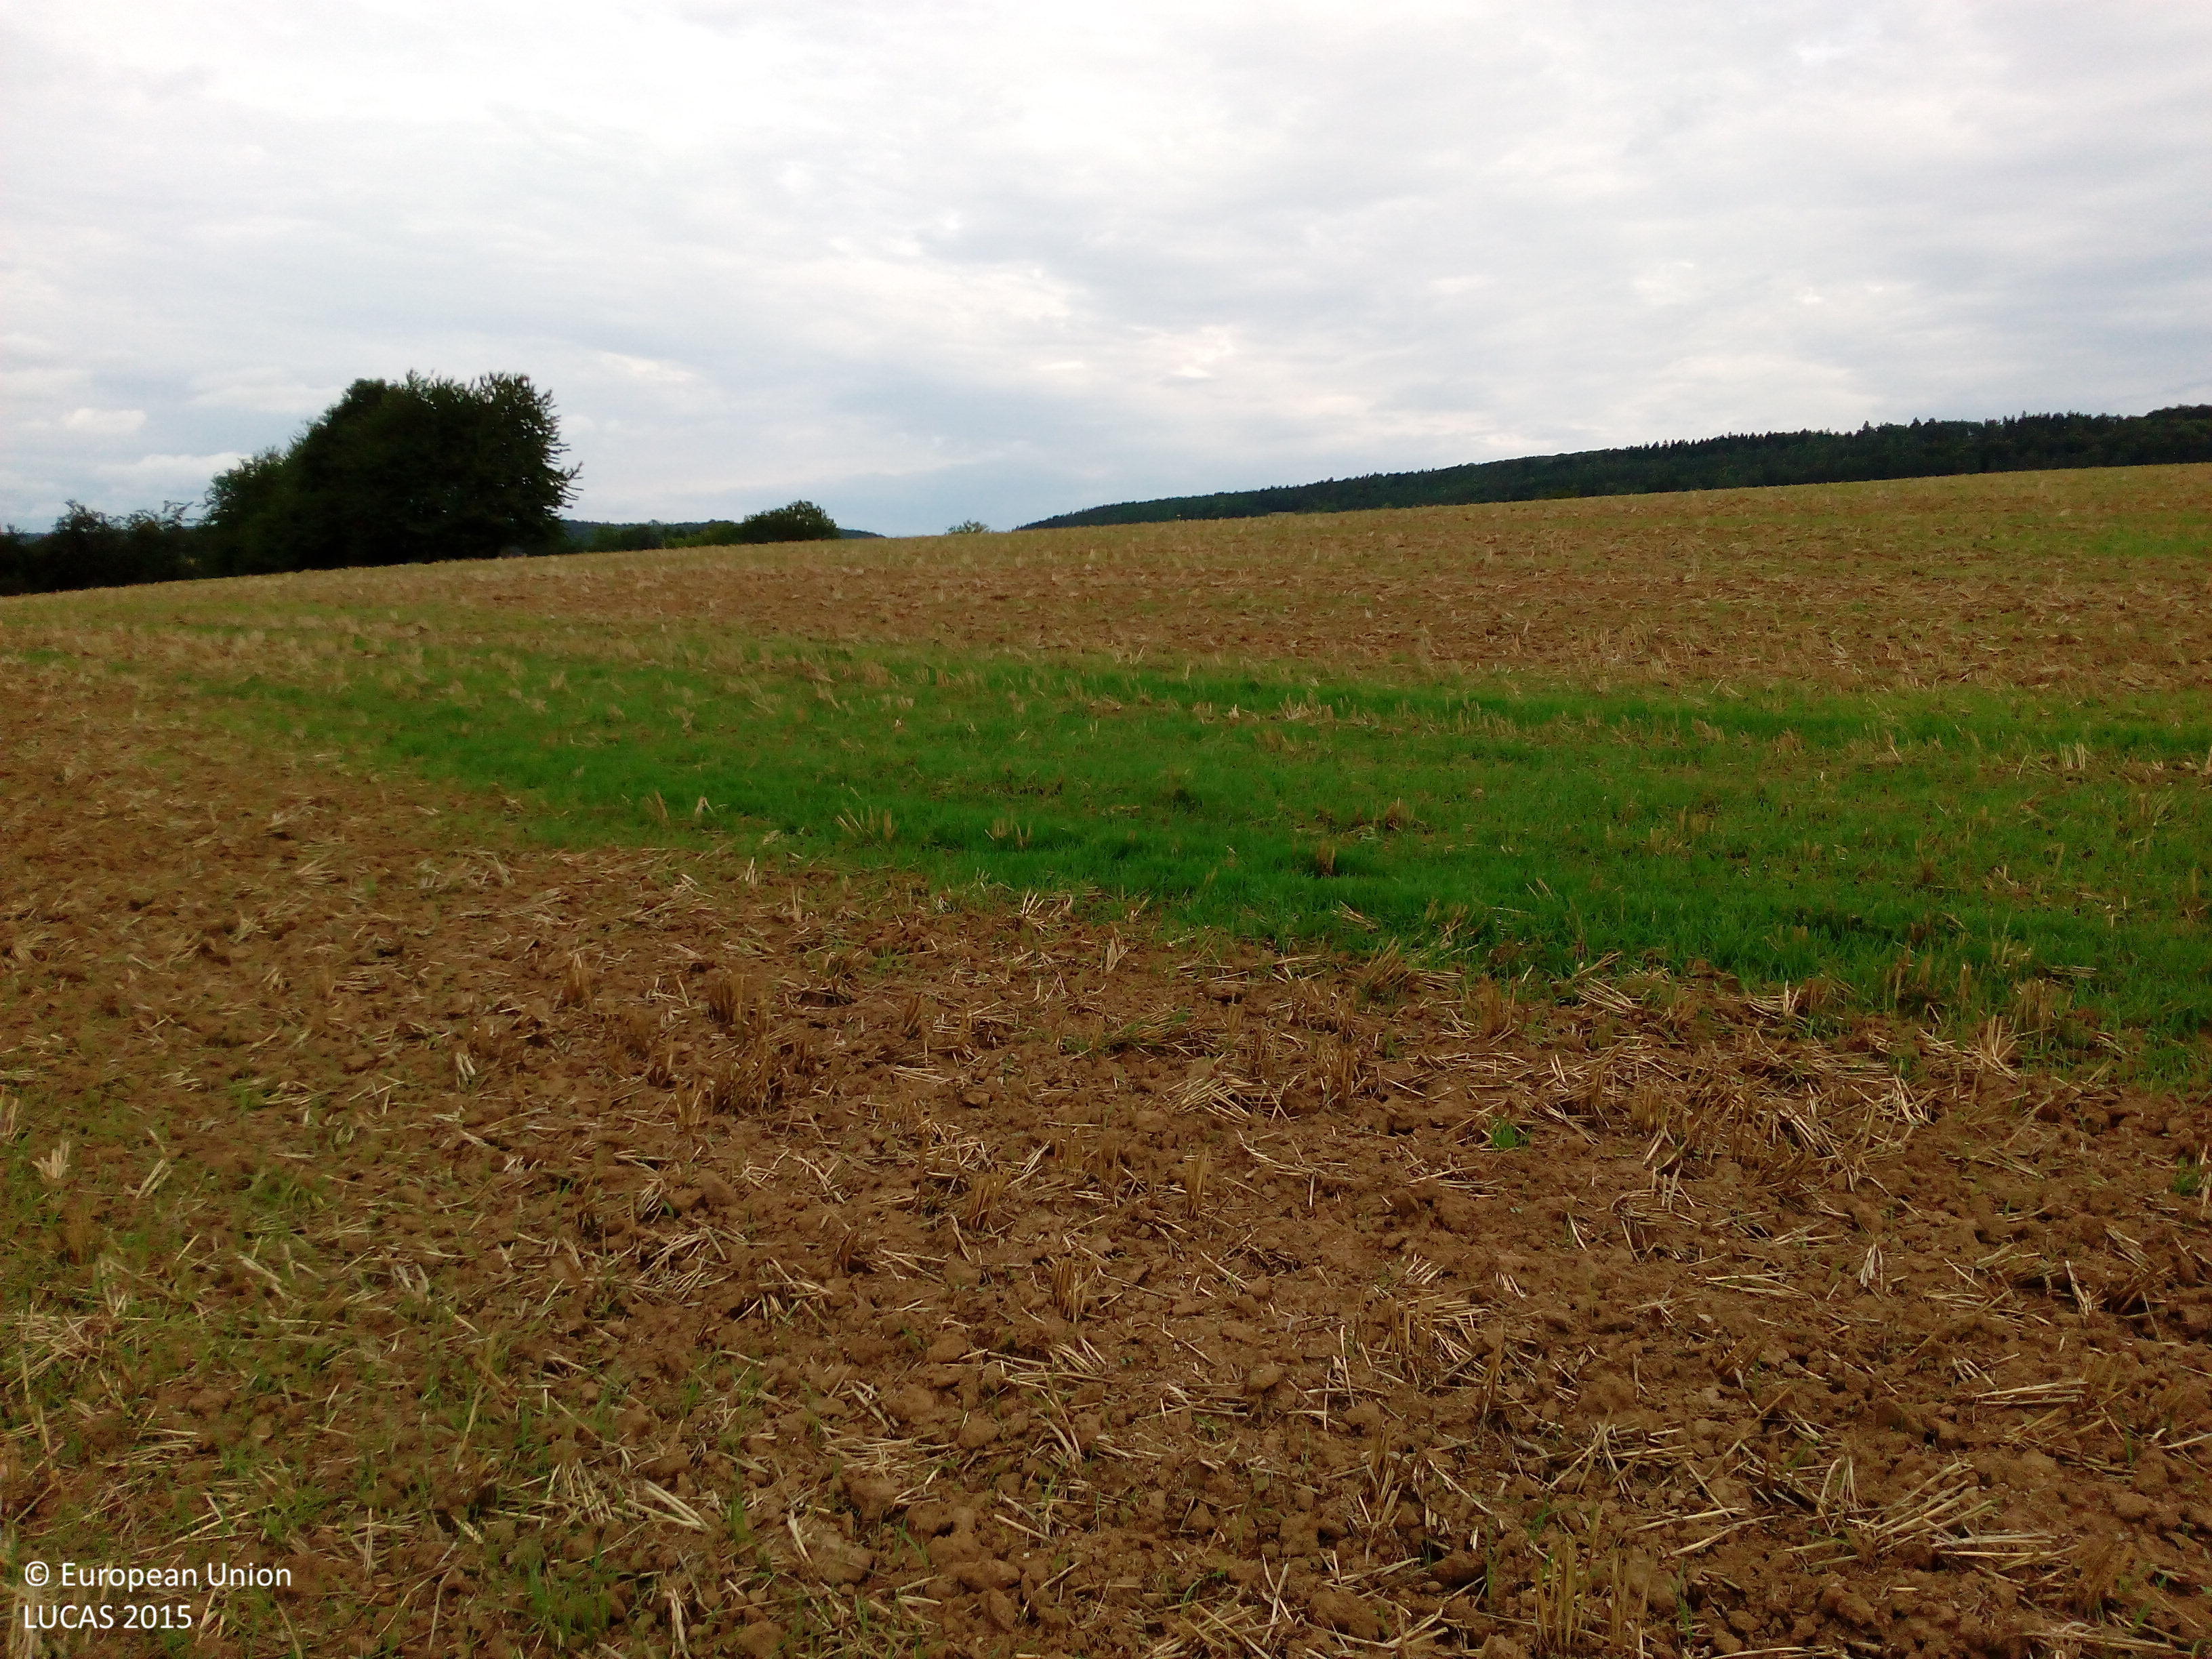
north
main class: Cropland
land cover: Common wheat
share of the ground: 25 - 50 %
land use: Agriculture (excluding fallow land and kitchen gardens)
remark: Harvested field
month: August
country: DE
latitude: 51.0647
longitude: 10.3566
